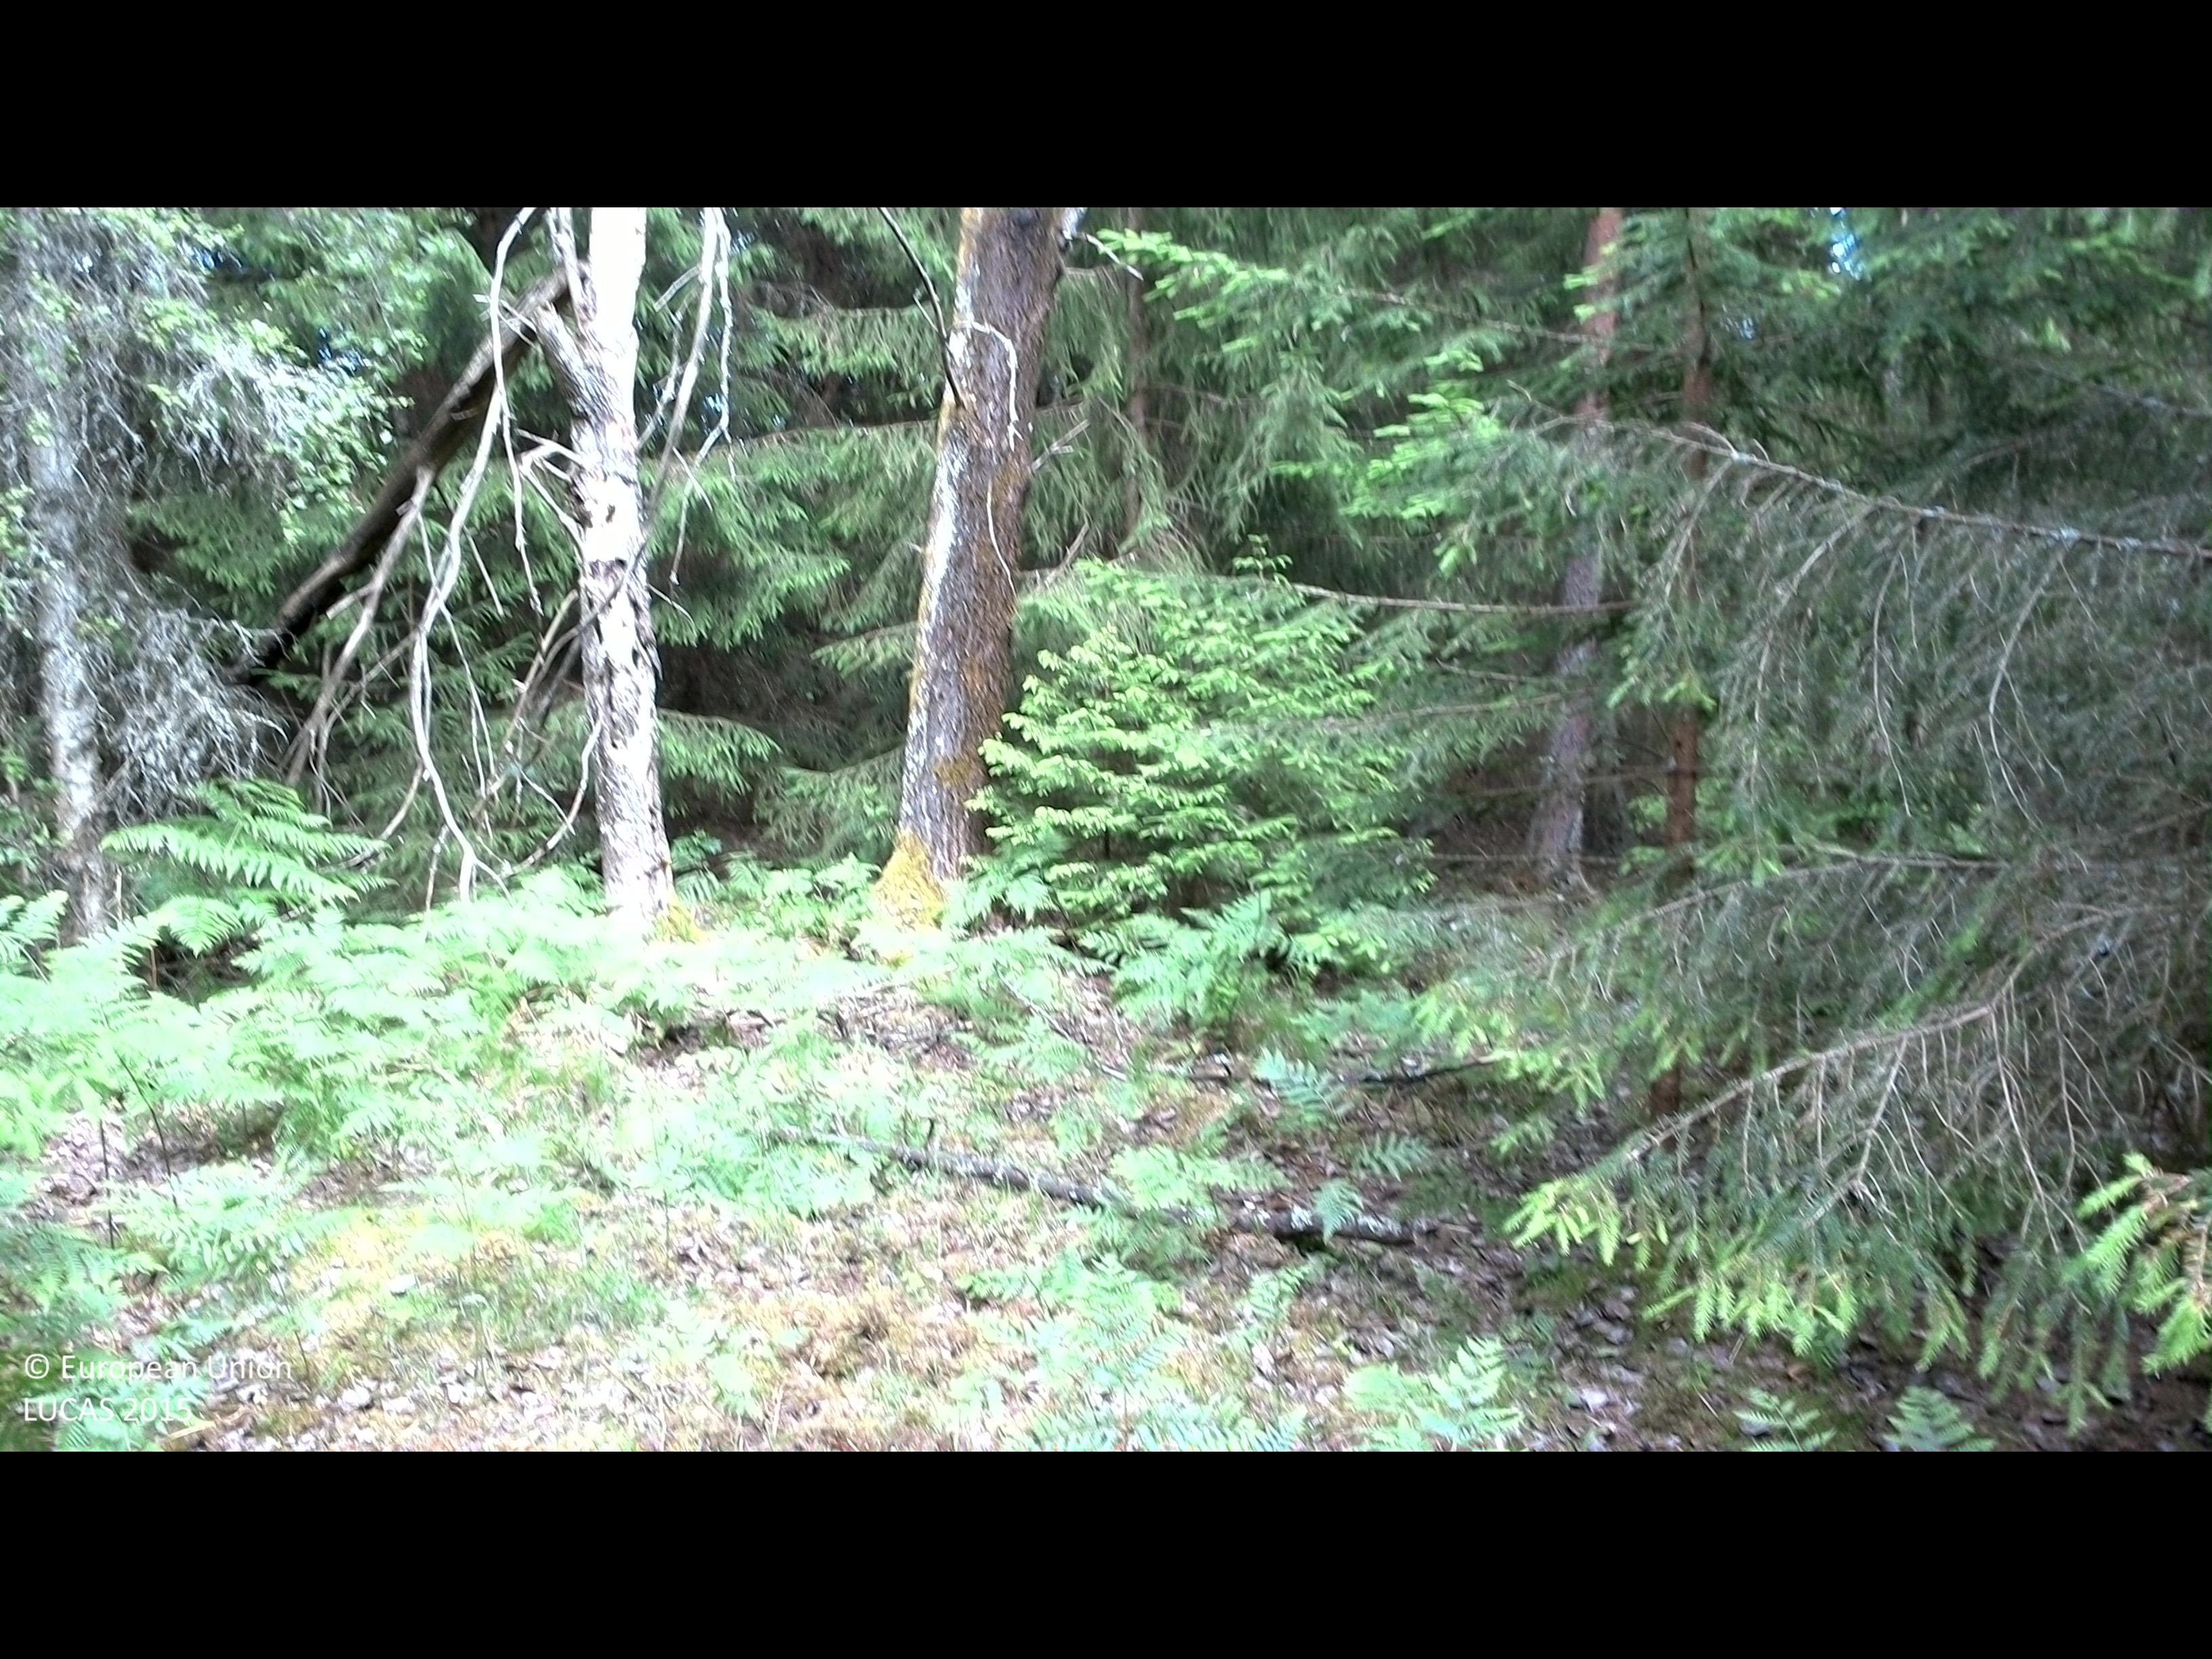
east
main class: Woodland
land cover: Spruce dominated coniferous woodland
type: boreal forest
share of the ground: > 75 %
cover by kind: coniferous forest trees 70 %, herbaceous plants 15 %, broadleaved forest trees 5 %, shrubs 5 %, lichens and mosses 5 %
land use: Forestry
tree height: > 5 m
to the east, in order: Spruce dominated coniferous woodland; Spruce dominated mixed woodland; Broadleaved woodland; Rivers and streams; Broadleaved woodland; Spruce dominated coniferous woodland; Tracks; Ditches and canals; Spruce dominated mixed woodland; Broadleaved woodland
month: July
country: SE
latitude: 56.4768
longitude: 14.7873
